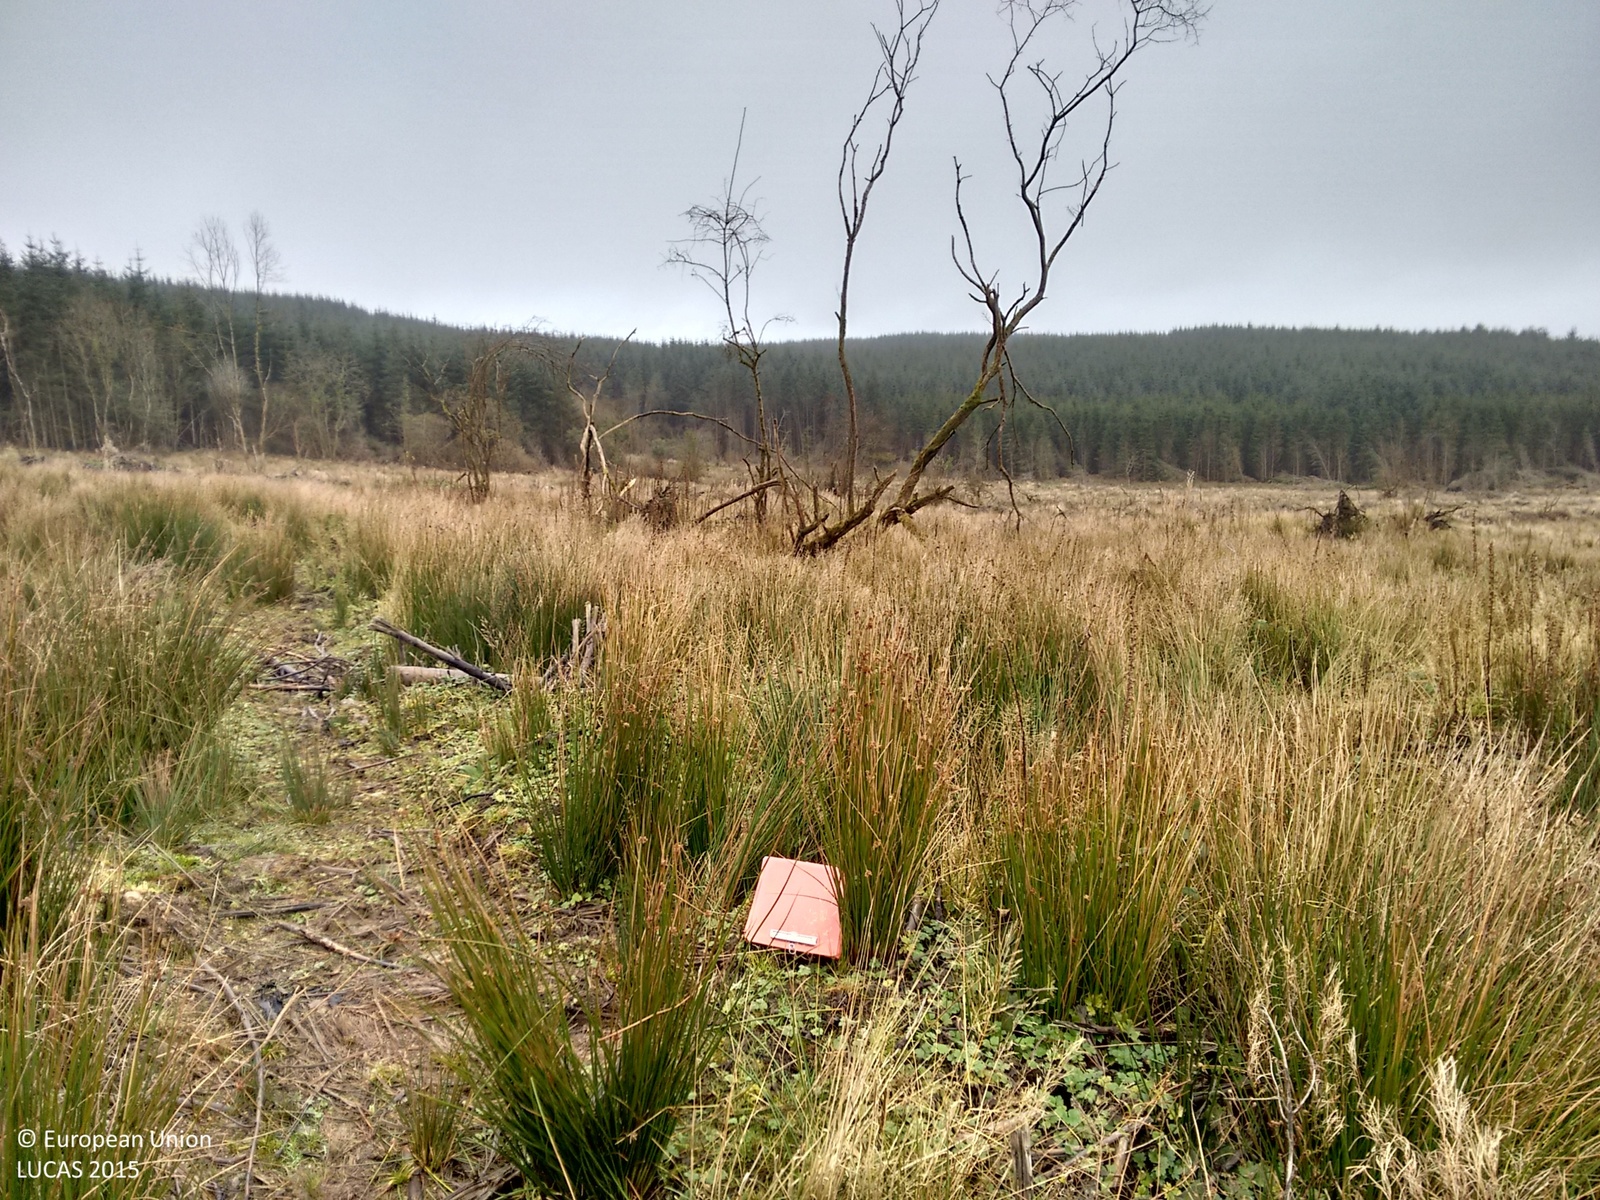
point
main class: Grassland
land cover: Spontaneously vegetated surfaces
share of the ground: > 75 %
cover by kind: herbaceous plants 95 %, shrubs 5 %
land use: Forestry
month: November
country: IE
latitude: 54.0924
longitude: -7.8274
